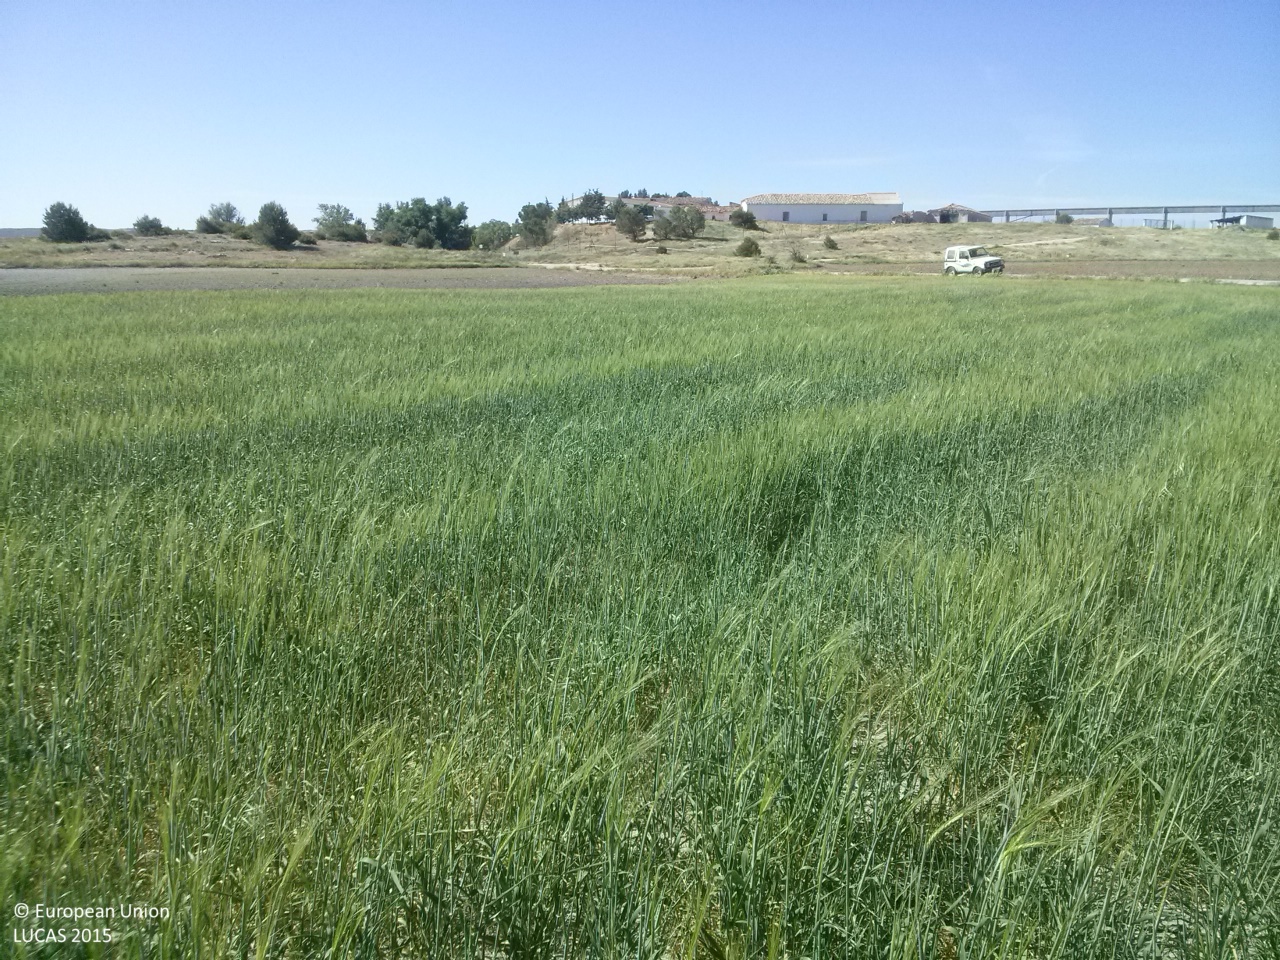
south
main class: Cropland
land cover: Barley
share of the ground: > 75 %
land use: Agriculture (excluding fallow land and kitchen gardens)
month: May
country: ES
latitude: 39.9510
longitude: -2.6962
